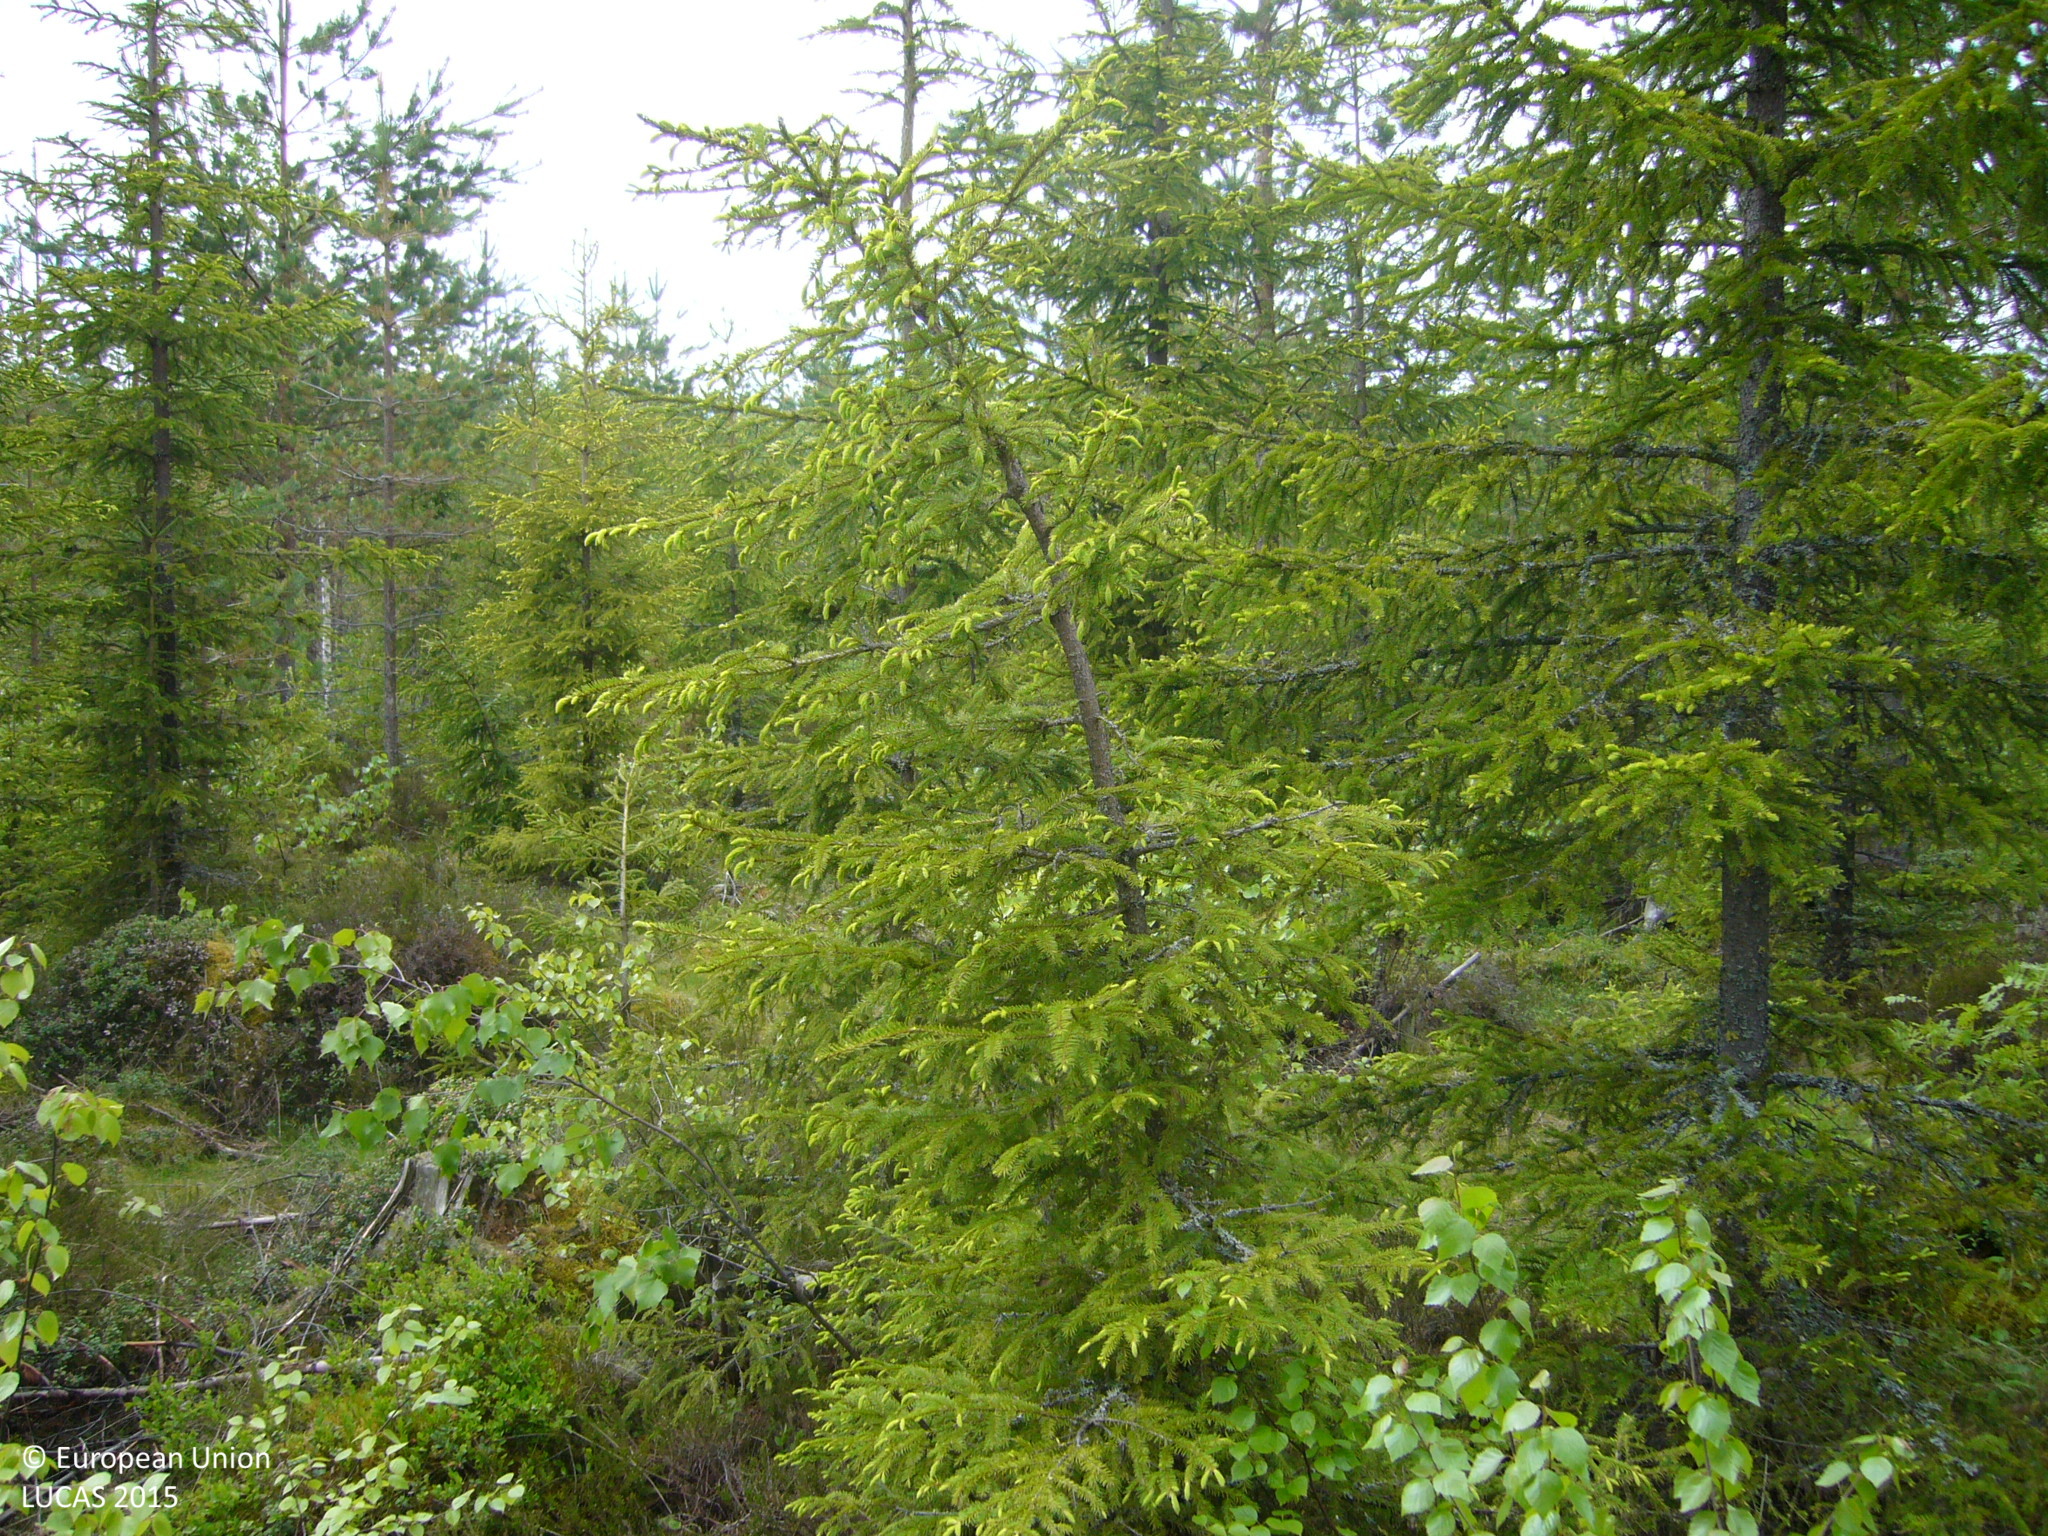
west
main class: Woodland
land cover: Spruce dominated coniferous woodland
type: boreal forest
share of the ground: 50 - 75 %
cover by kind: coniferous forest trees 50 %, shrubs 40 %, broadleaved forest trees 10 %
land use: Forestry
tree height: > 5 m
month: June
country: FI
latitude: 63.2786
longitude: 26.2079
